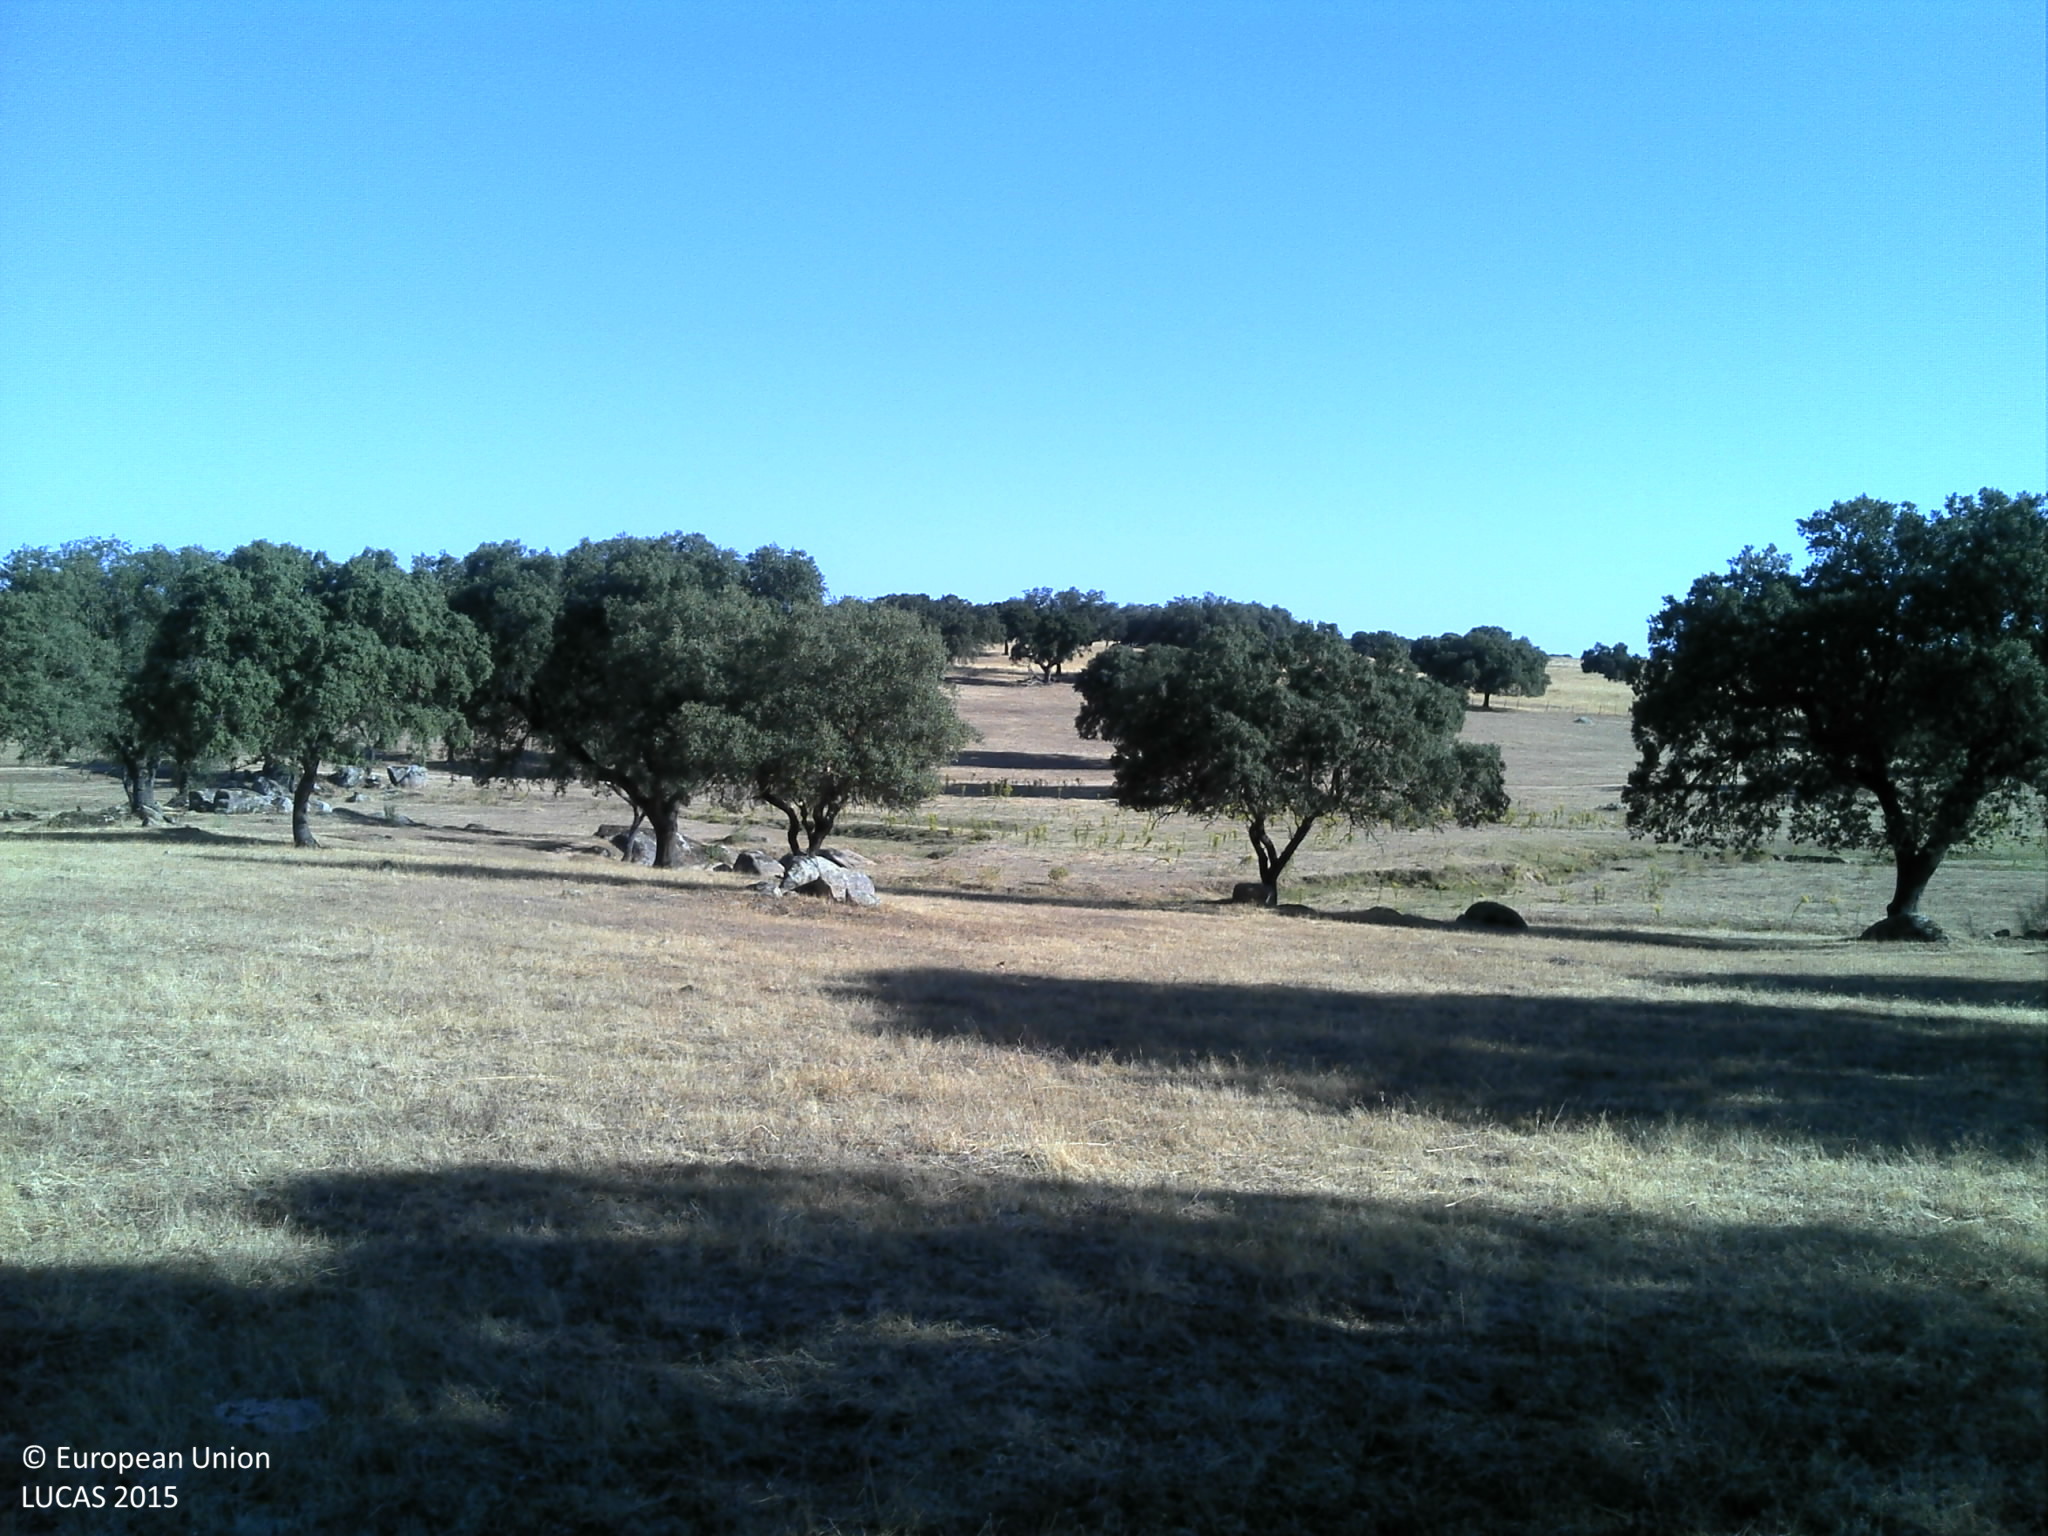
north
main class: Woodland
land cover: Broadleaved woodland
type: broadleaved evergreen forest
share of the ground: 25 - 50 %
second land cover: Grassland without tree/shrub cover
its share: 25 - 50 %
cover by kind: unconsolidated bare surface 50 %, broadleaved forest trees 25 %, herbaceous plants 25 %
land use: Forestry
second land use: Agriculture (excluding fallow land and kitchen gardens)
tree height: > 5 m
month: July
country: PT
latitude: 39.0316
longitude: -7.3984
